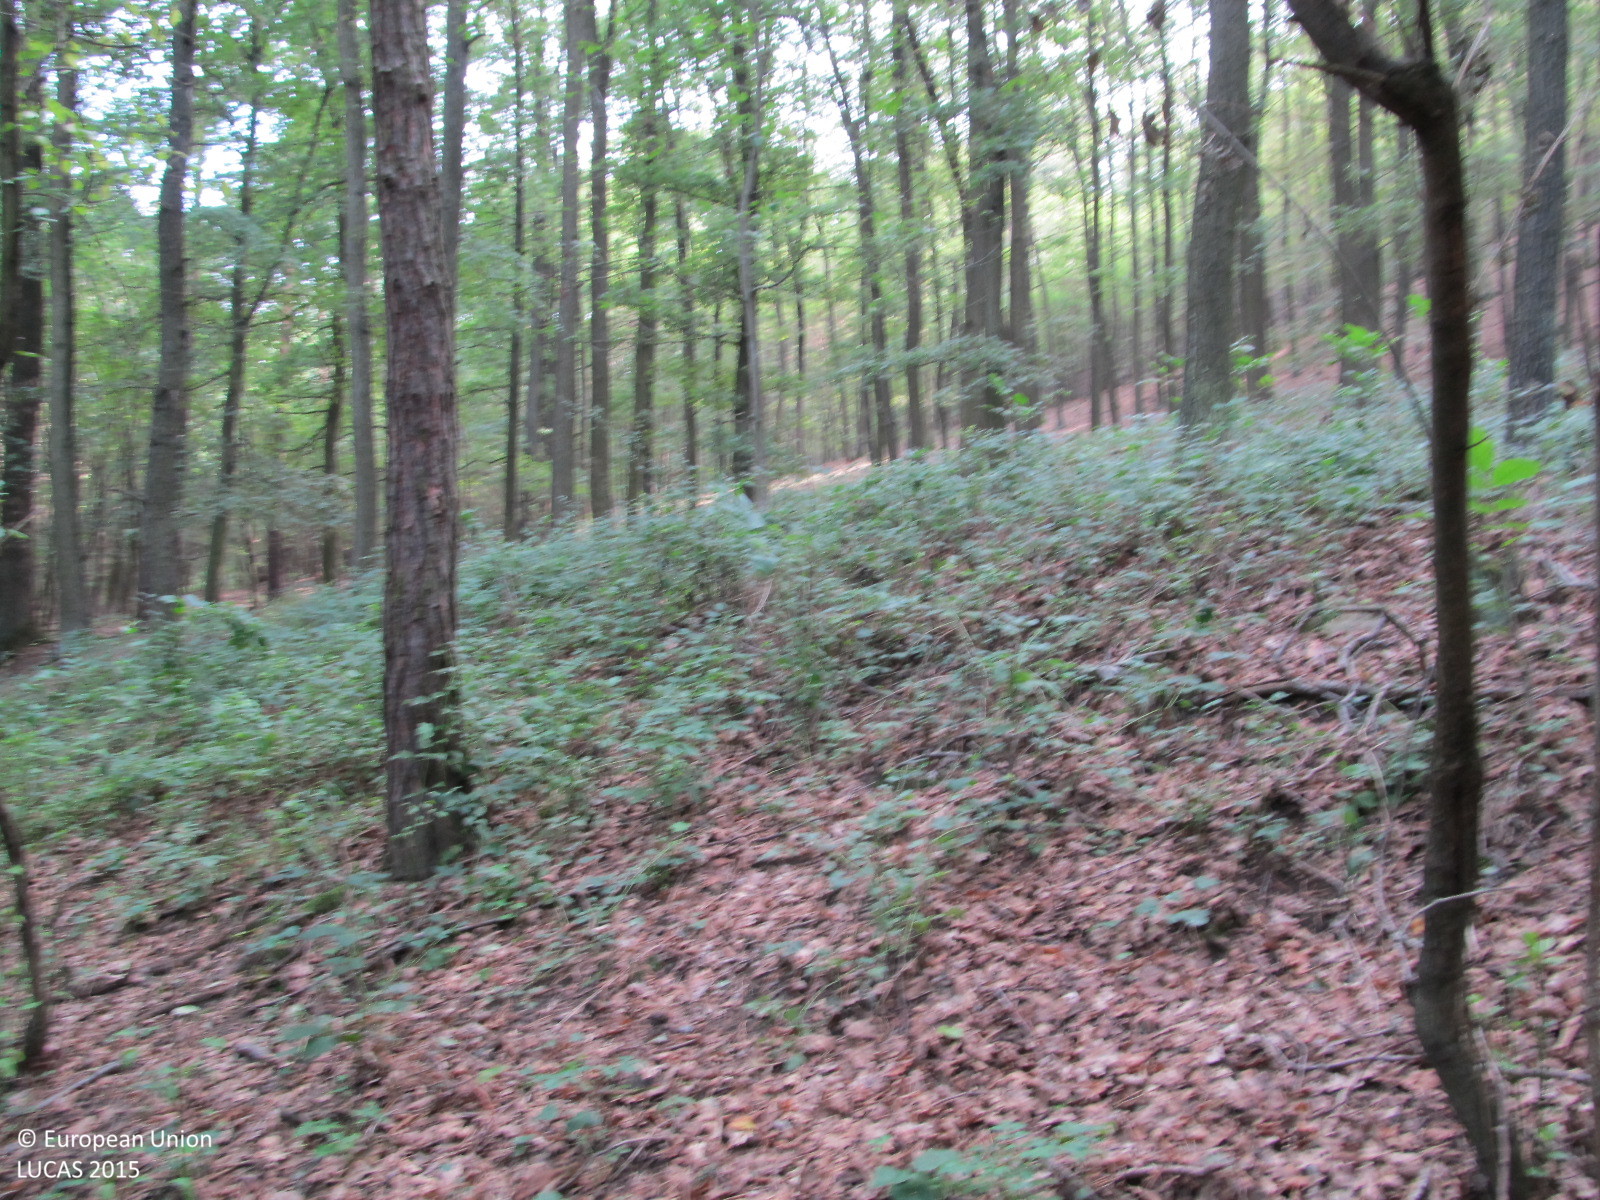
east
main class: Woodland
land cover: Other mixed woodland
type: hemiboreal forest and nemoral coniferous forest and mixed broadleaved-coniferous forest
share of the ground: > 75 %
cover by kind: broadleaved forest trees 60 %, coniferous forest trees 20 %, herbaceous plants 10 %, unconsolidated bare surface 10 %
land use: Forestry
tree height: > 5 m
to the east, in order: Other mixed woodland; Spruce dominated mixed woodland; Other mixed woodland
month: September
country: AT
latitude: 48.3323
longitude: 15.6279
